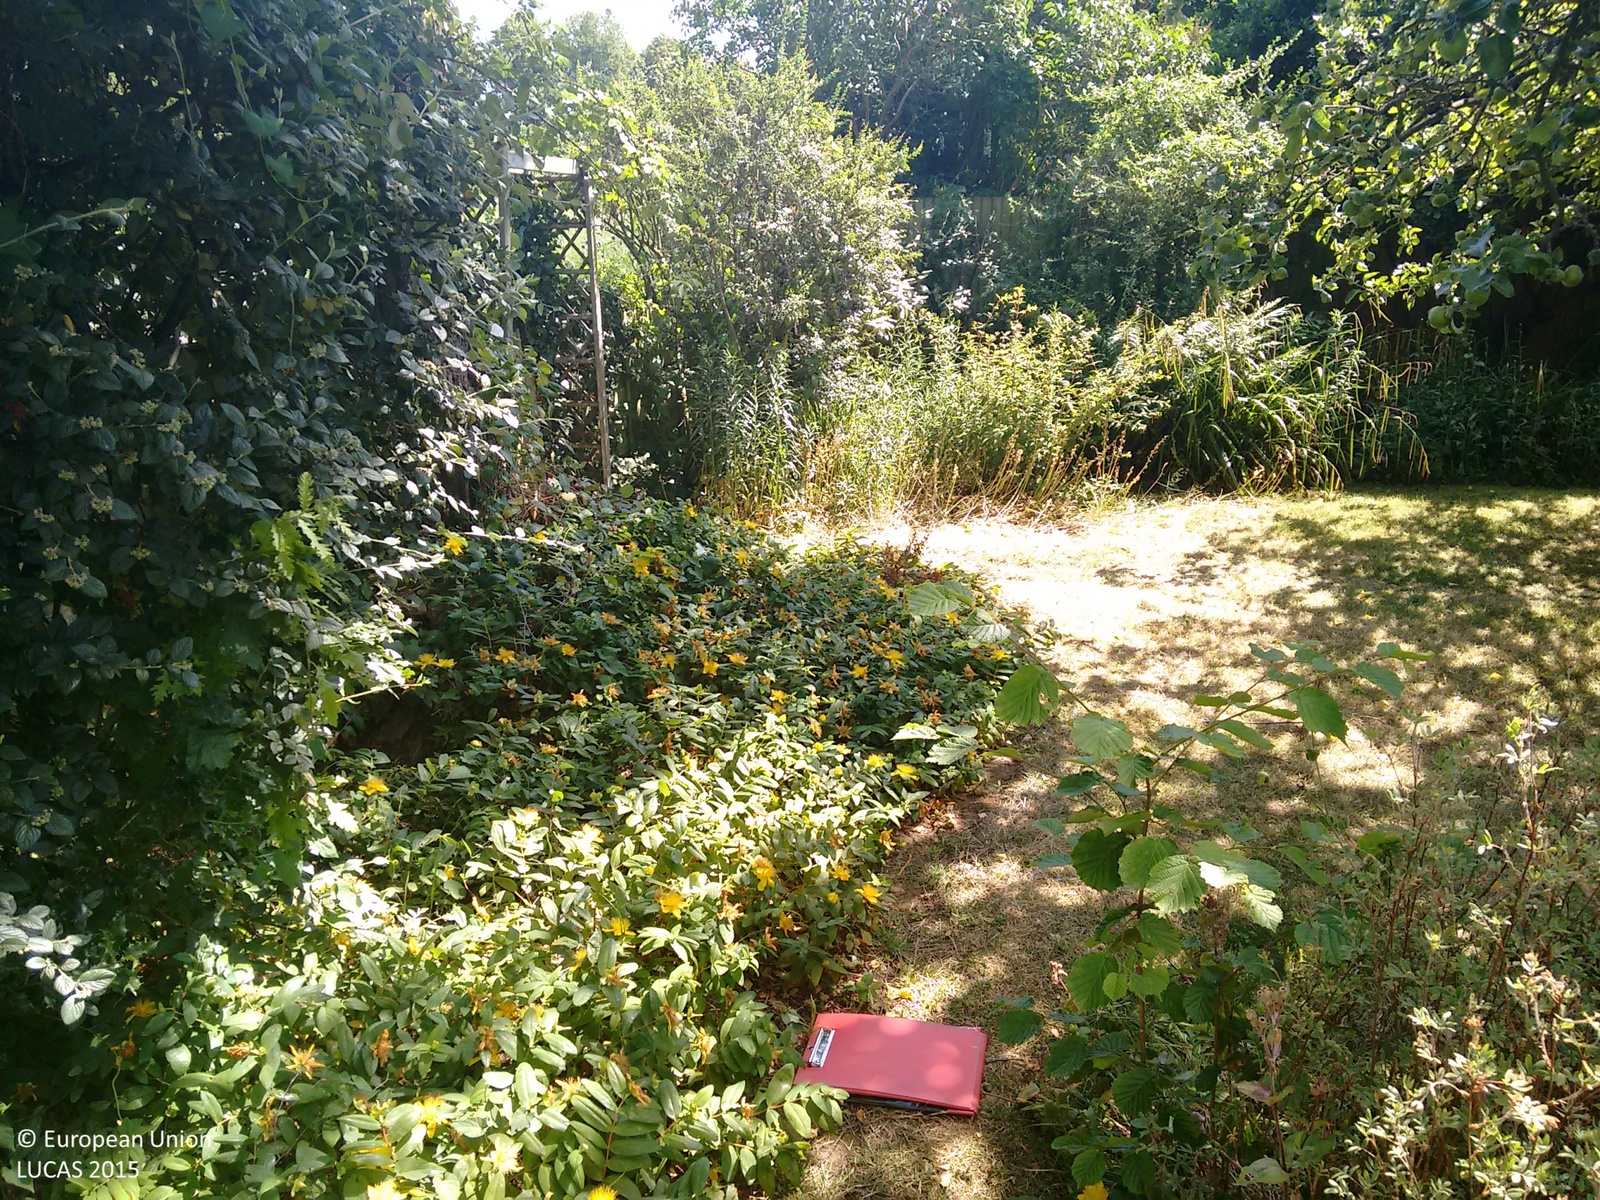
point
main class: Woodland
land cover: Broadleaved woodland
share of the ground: > 75 %
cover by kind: broadleaved forest trees 100 %
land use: Residential
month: July
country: GB
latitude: 51.1750
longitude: -0.6101
